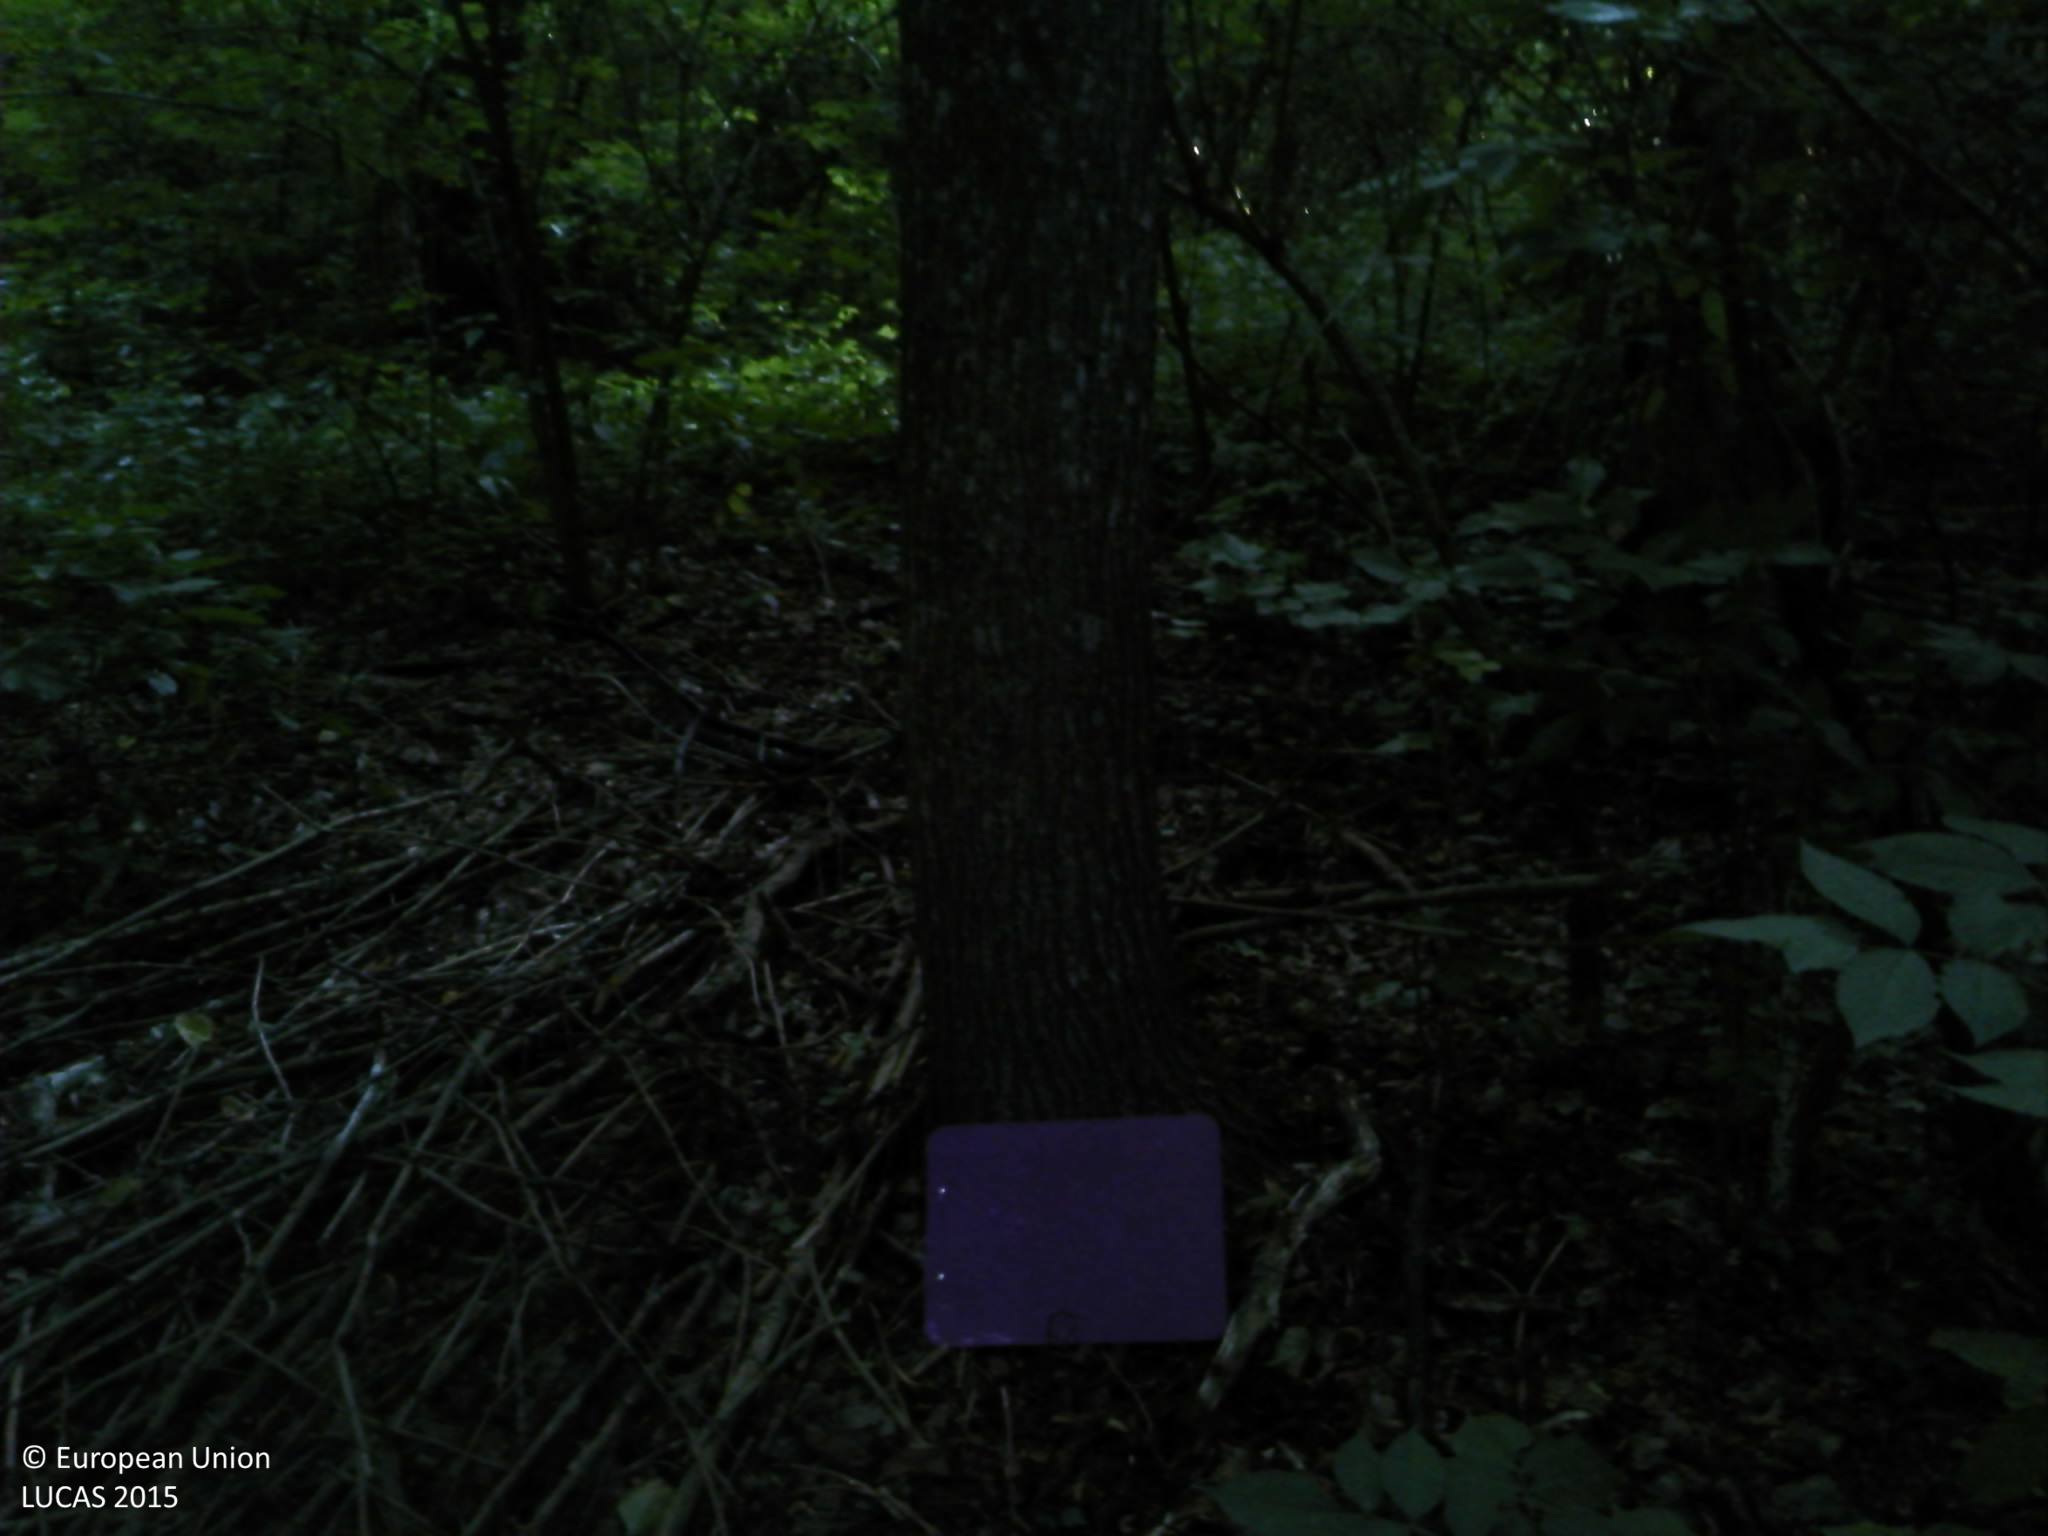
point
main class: Woodland
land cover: Broadleaved woodland
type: mesophytic deciduous forest
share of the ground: > 75 %
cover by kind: broadleaved forest trees 90 %, shrubs 5 %, herbaceous plants 5 %
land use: Forestry
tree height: > 5 m
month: July
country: HR
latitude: 45.8757
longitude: 16.8933
